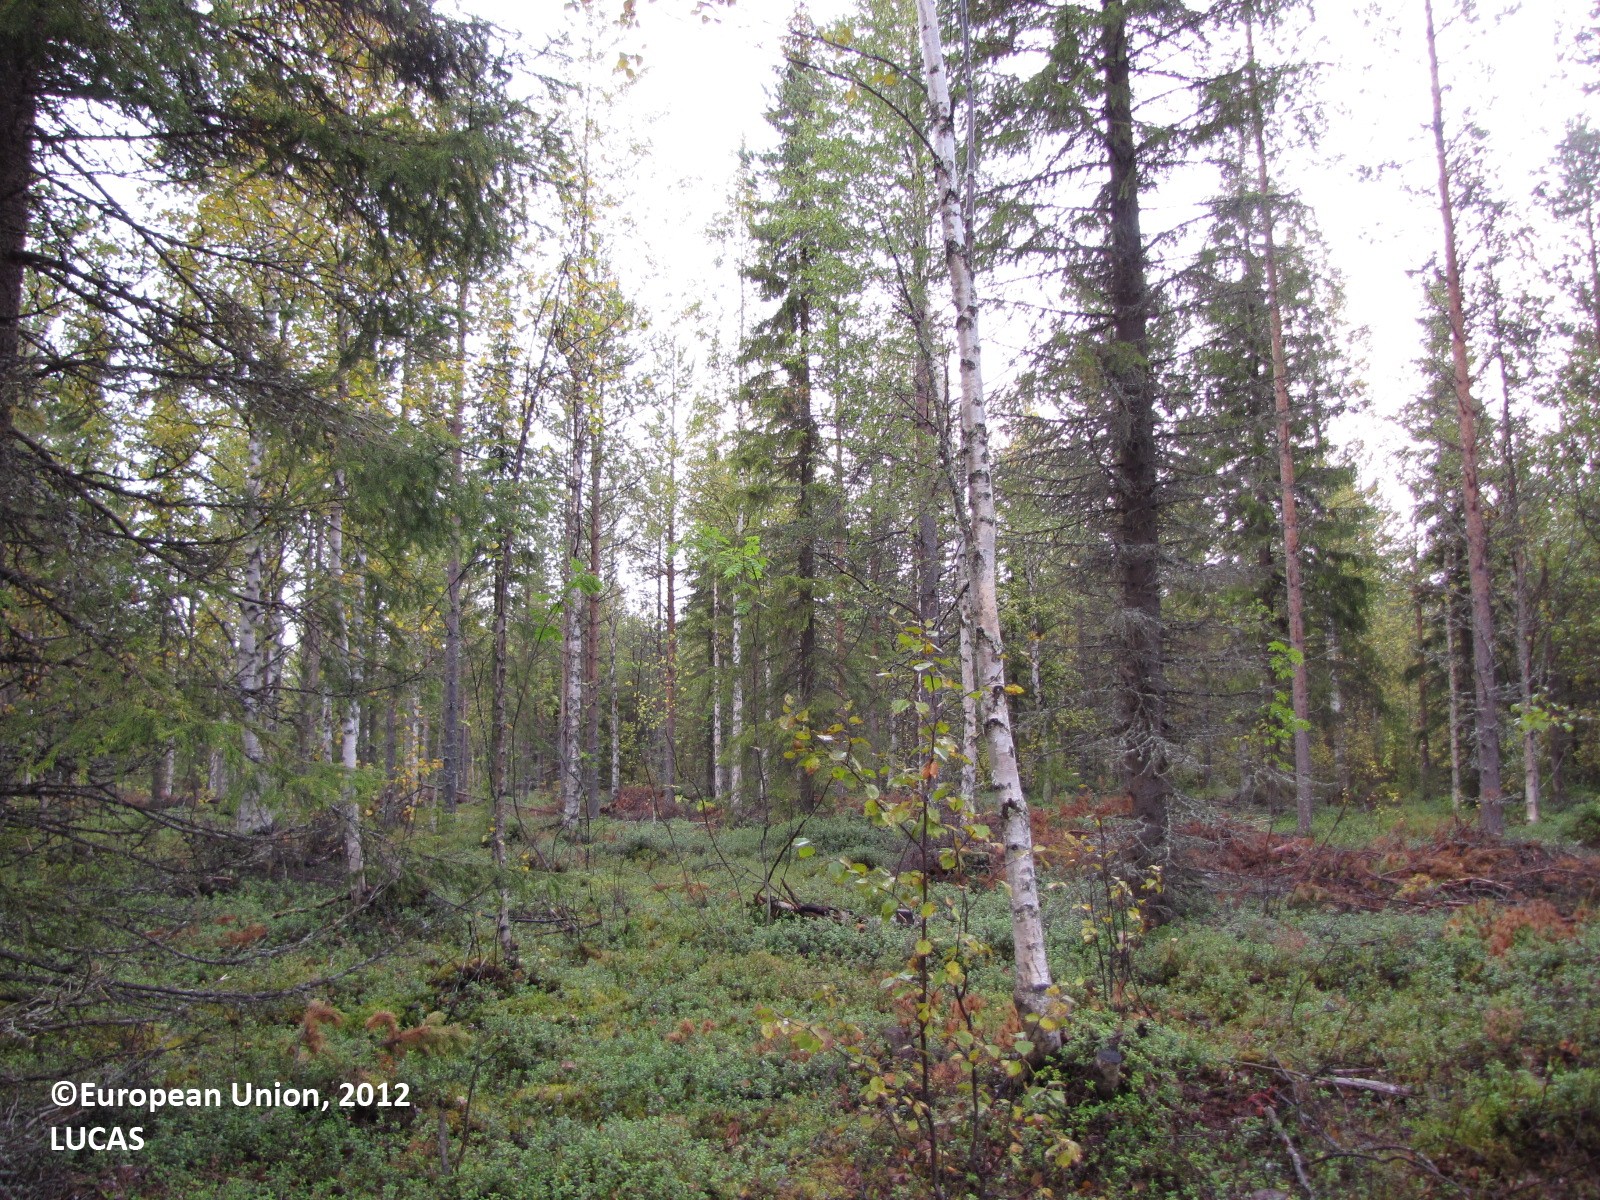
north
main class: Woodland
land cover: Other mixed woodland
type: boreal forest
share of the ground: 10 - 25 %
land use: Forestry
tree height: > 5 m
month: September
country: FI
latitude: 67.2689
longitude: 23.8692
